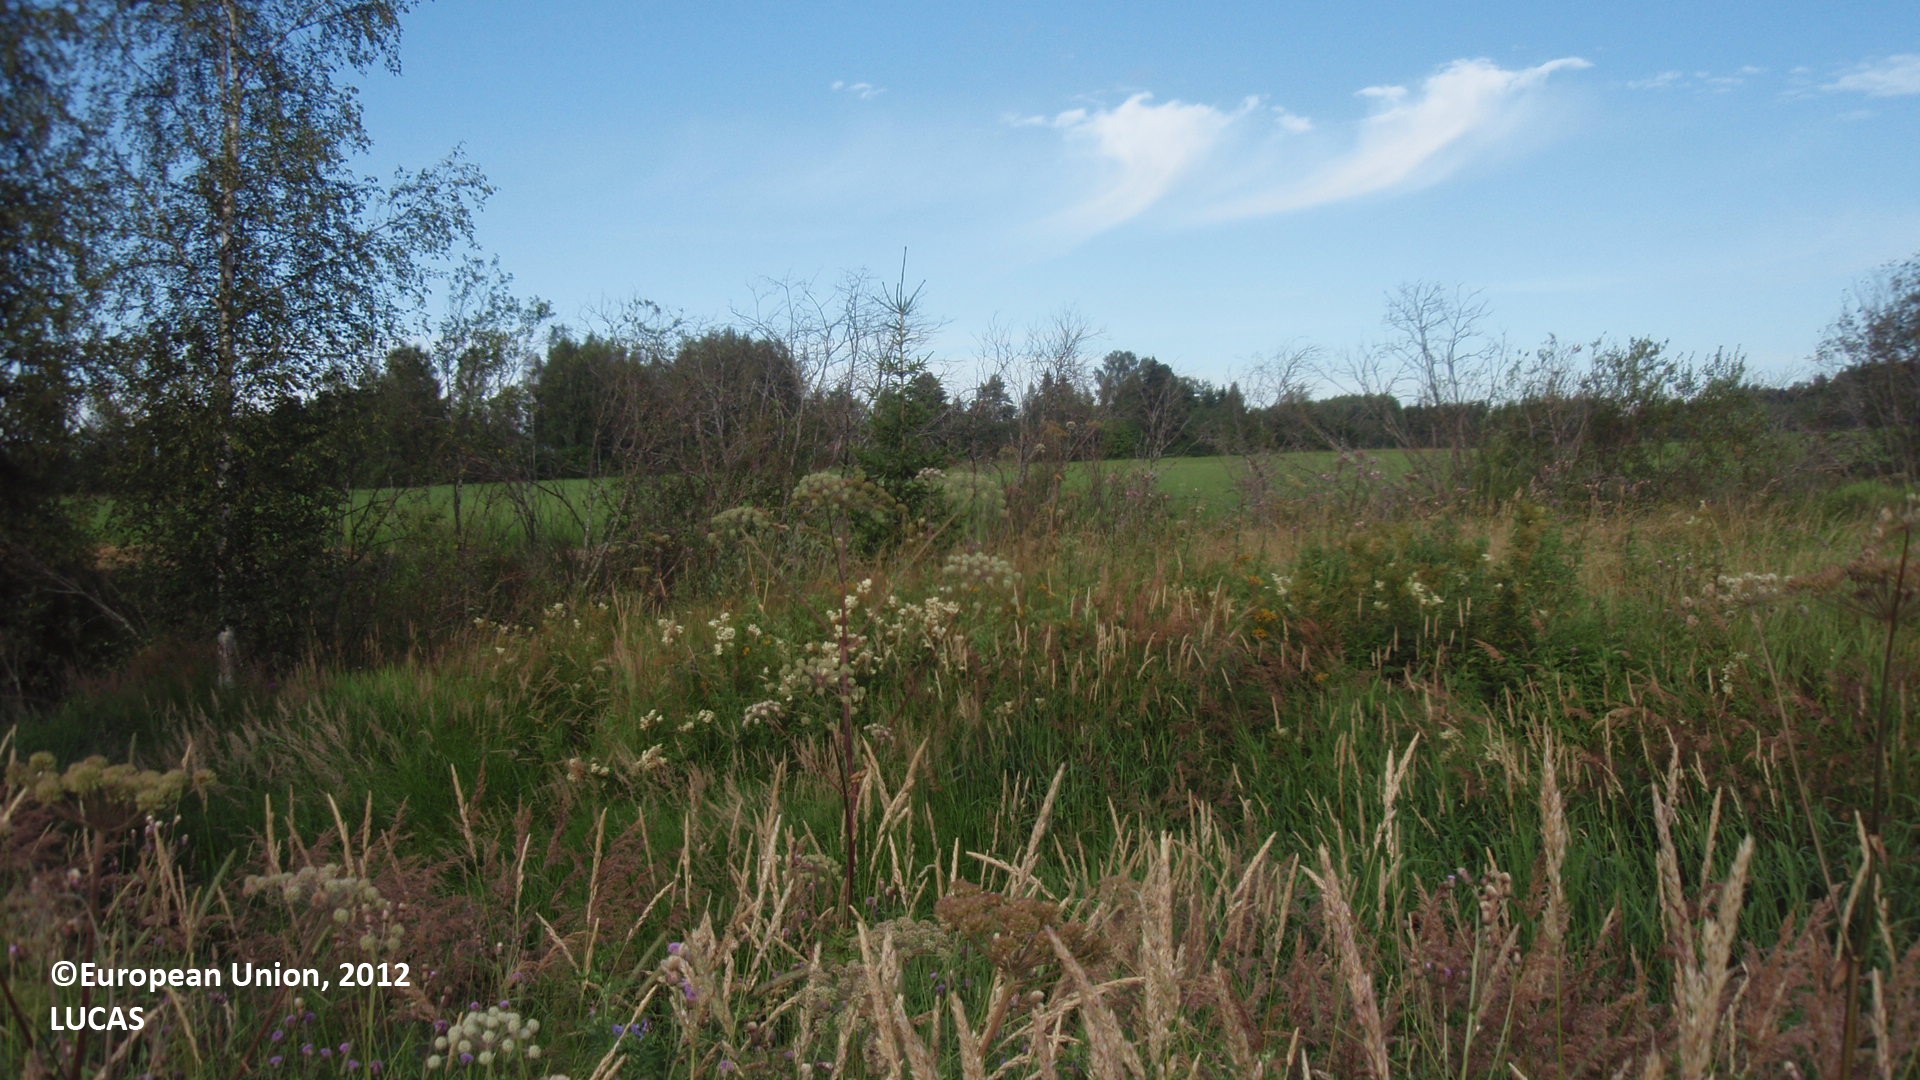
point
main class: Cropland
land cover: Mixed cereals for fodder
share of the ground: > 75 %
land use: Agriculture (excluding fallow land and kitchen gardens)
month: August
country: FI
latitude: 61.2134
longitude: 28.0128
